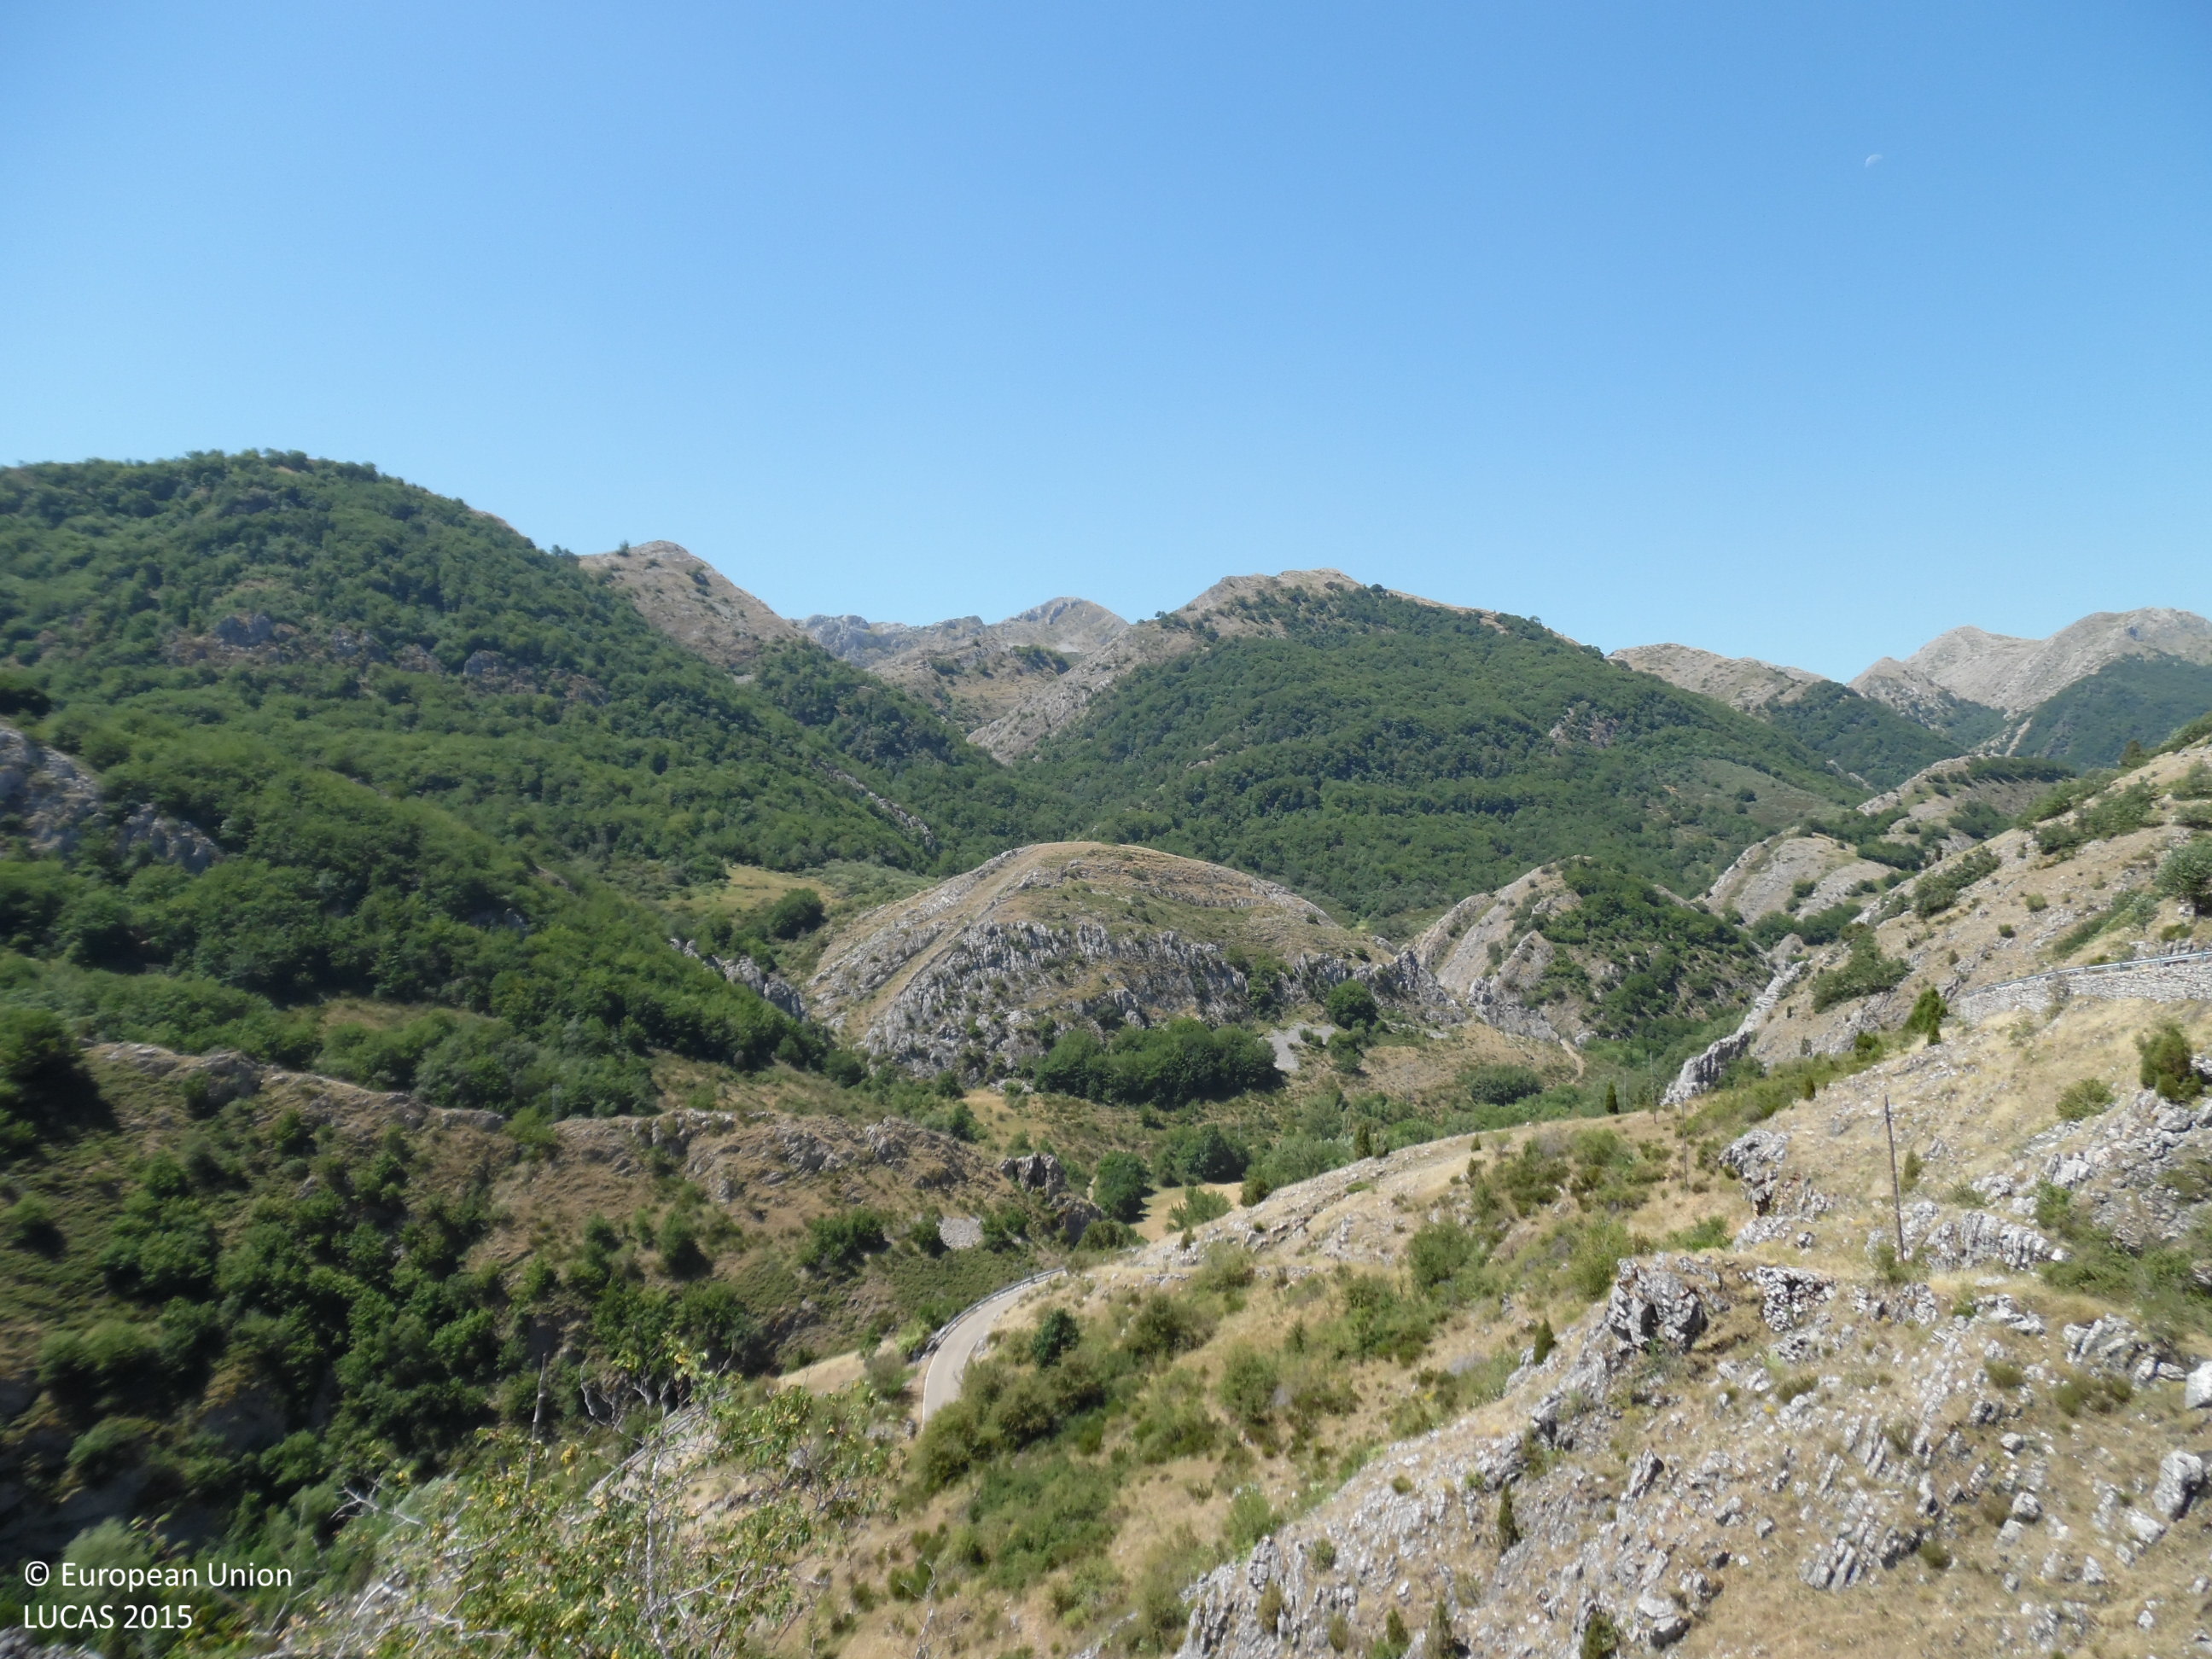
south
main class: Grassland
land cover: Grassland with sparse tree/shrub cover
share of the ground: > 75 %
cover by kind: herbaceous plants 90 %, broadleaved forest trees 5 %, shrubs 5 %
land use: Agriculture (excluding fallow land and kitchen gardens)
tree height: < 5 m
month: July
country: ES
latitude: 42.8834
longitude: -5.7393
